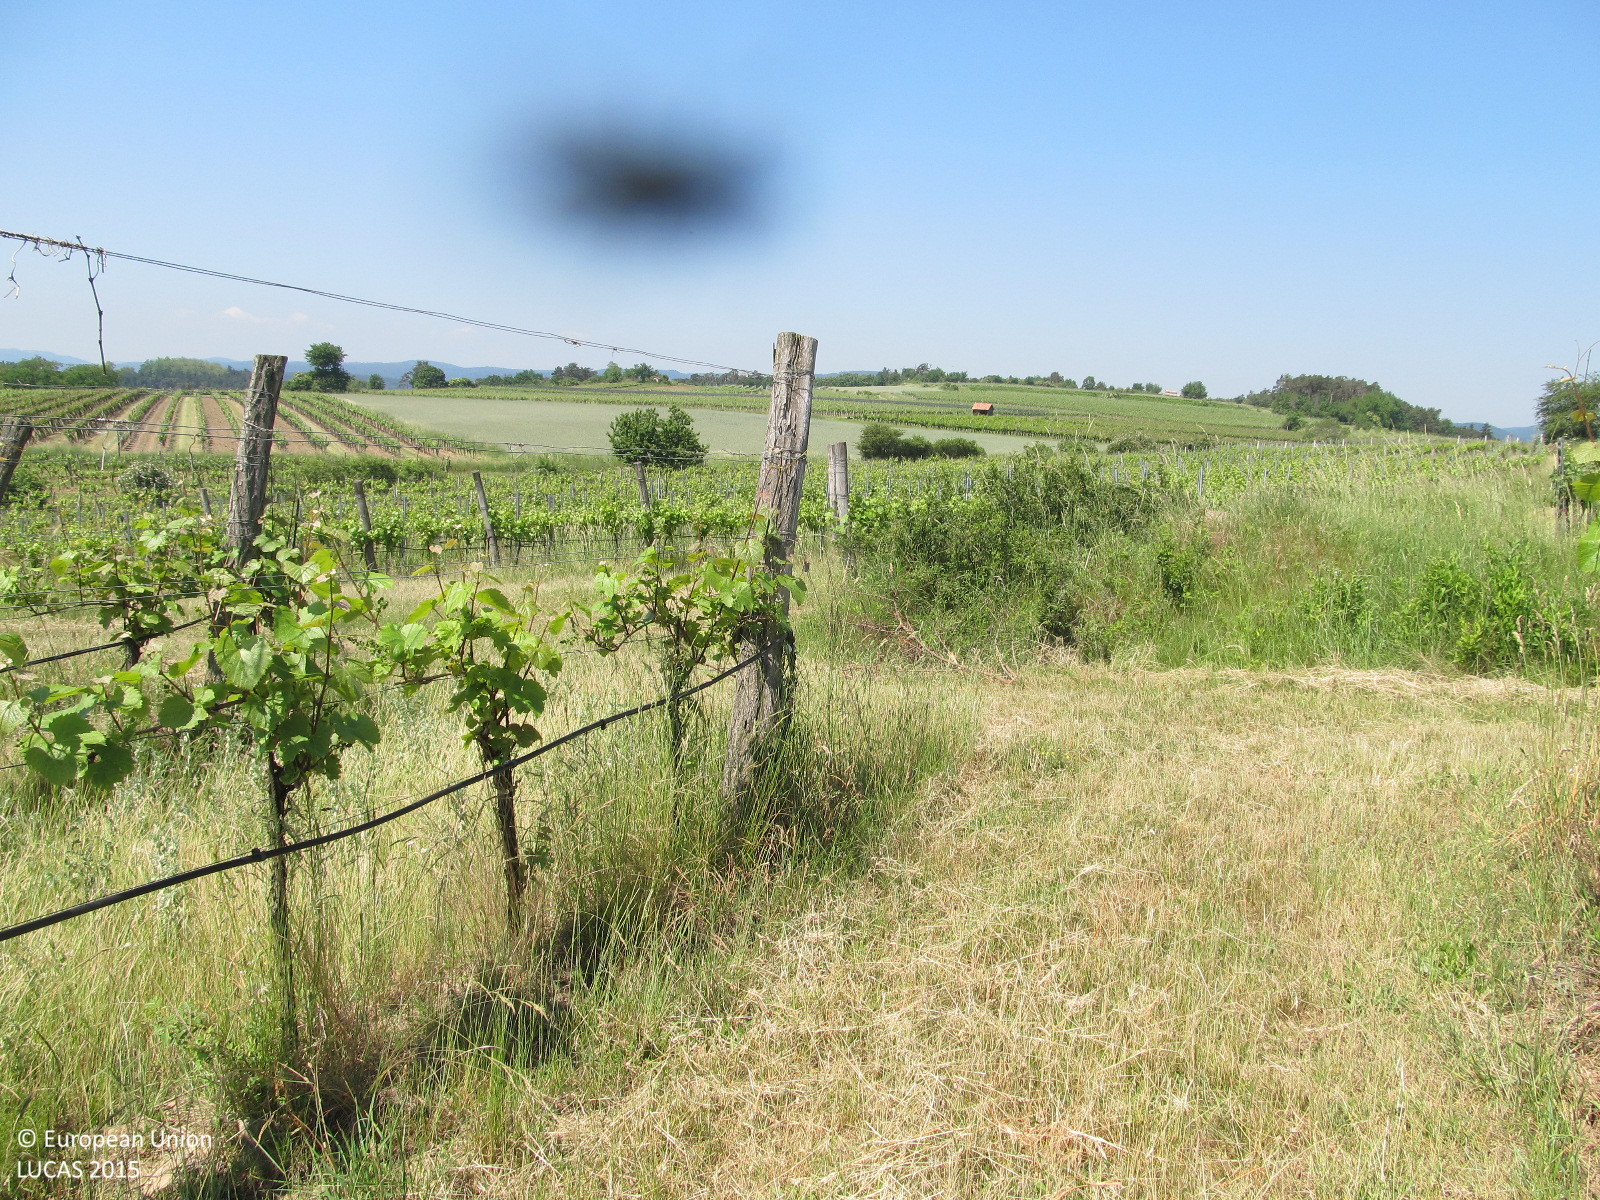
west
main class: Cropland
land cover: Vineyards
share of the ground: 10 - 25 %
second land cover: Grassland without tree/shrub cover
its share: > 75 %
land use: Agriculture (excluding fallow land and kitchen gardens)
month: May
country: AT
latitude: 48.4937
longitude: 15.6460
